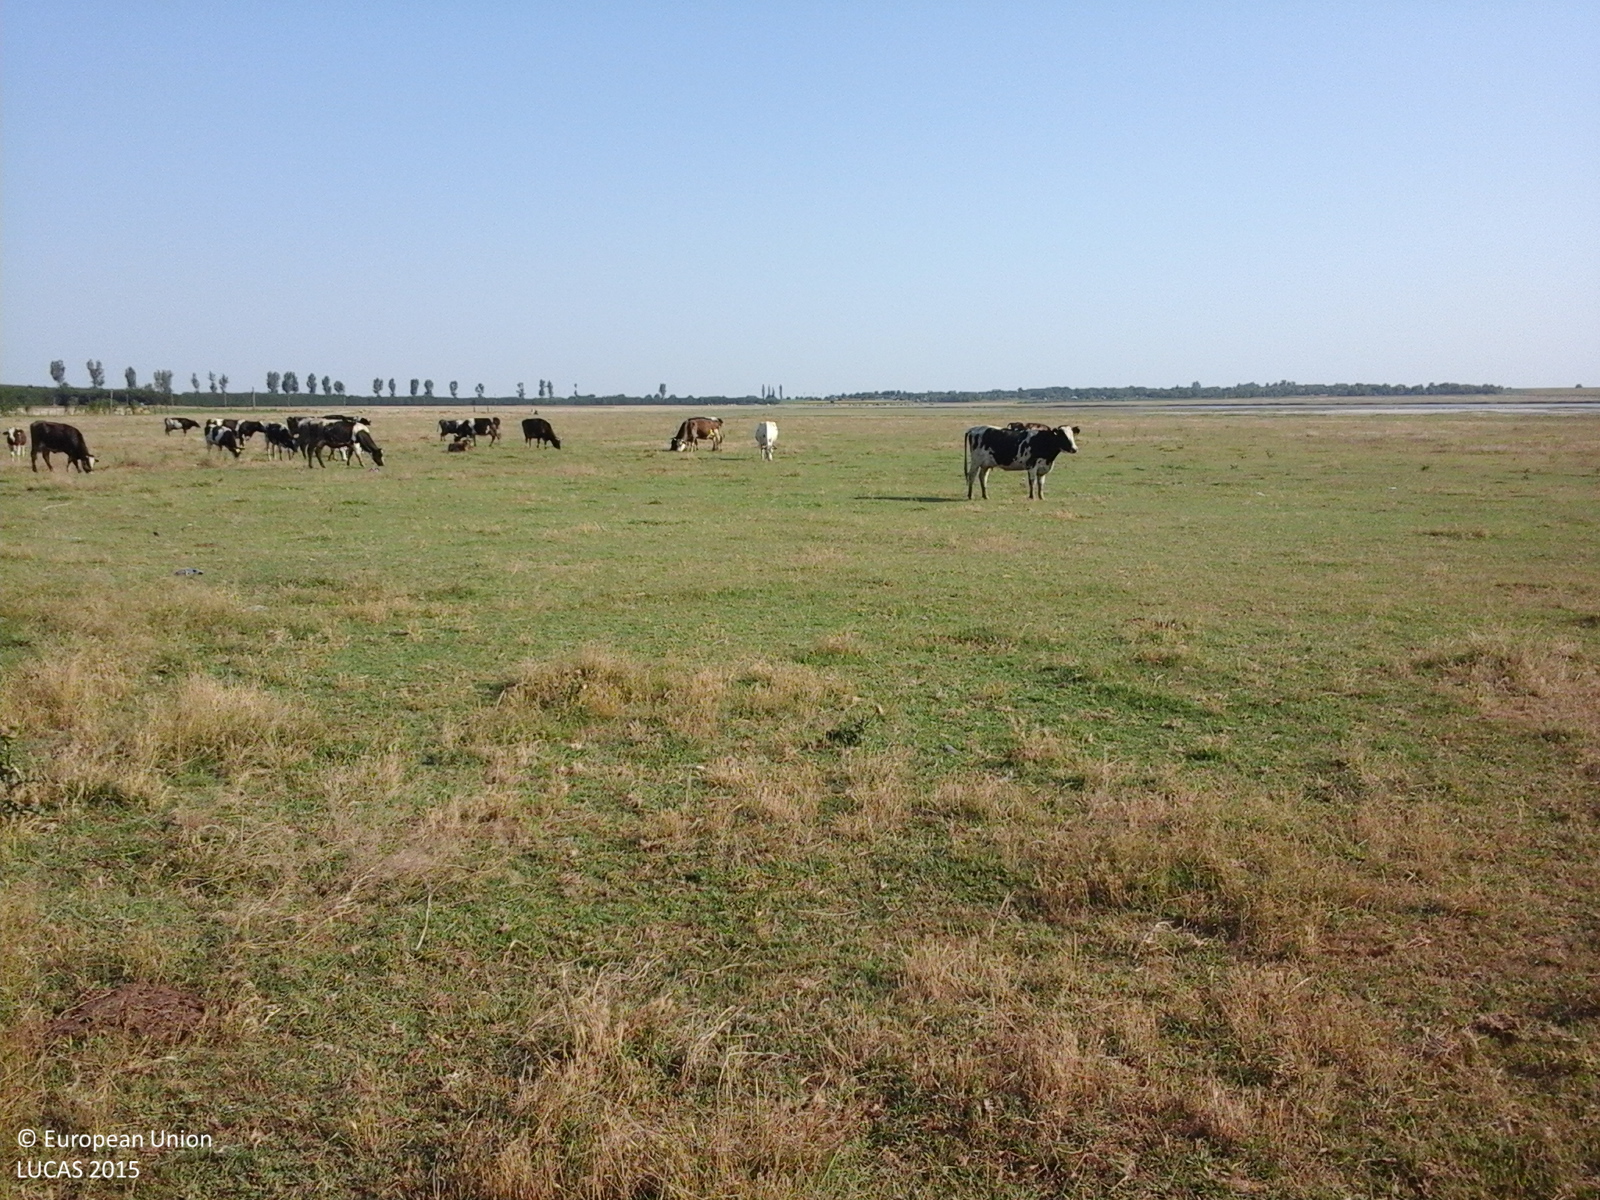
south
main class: Grassland
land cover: Grassland without tree/shrub cover
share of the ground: > 75 %
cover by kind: herbaceous plants 100 %
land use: Agriculture (excluding fallow land and kitchen gardens)
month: July
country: RO
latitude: 44.8037
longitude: 27.2706
